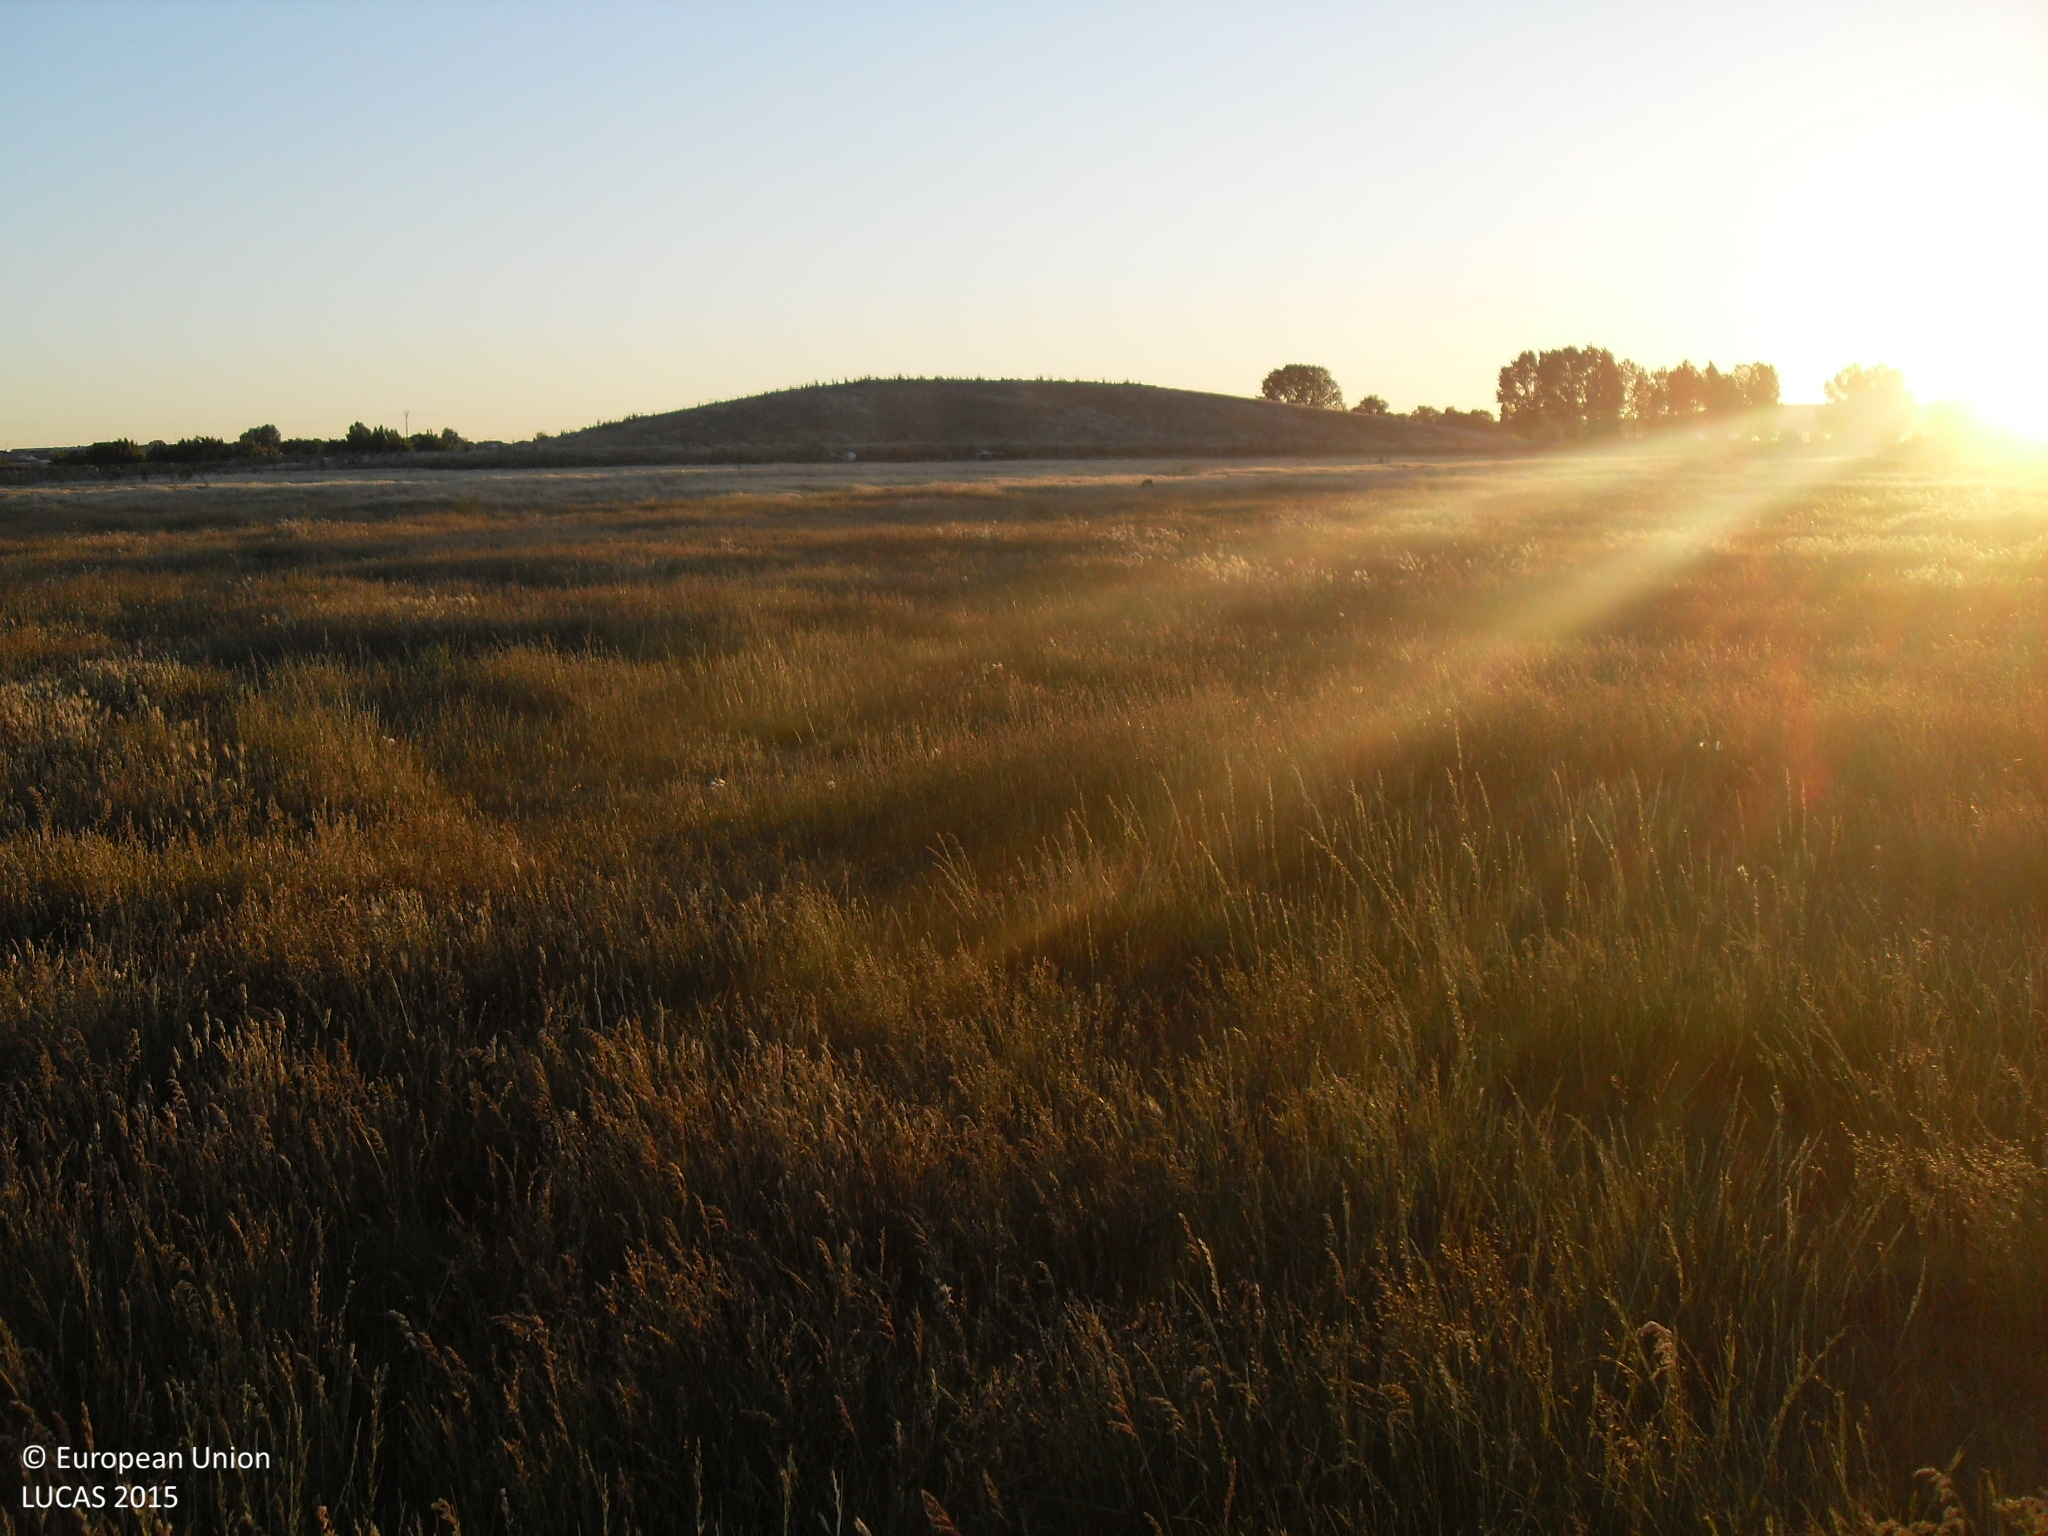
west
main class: Grassland
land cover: Grassland without tree/shrub cover
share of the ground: > 75 %
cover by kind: herbaceous plants 100 %
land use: Agriculture (excluding fallow land and kitchen gardens)
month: May
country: ES
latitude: 41.0592
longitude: -5.3147
